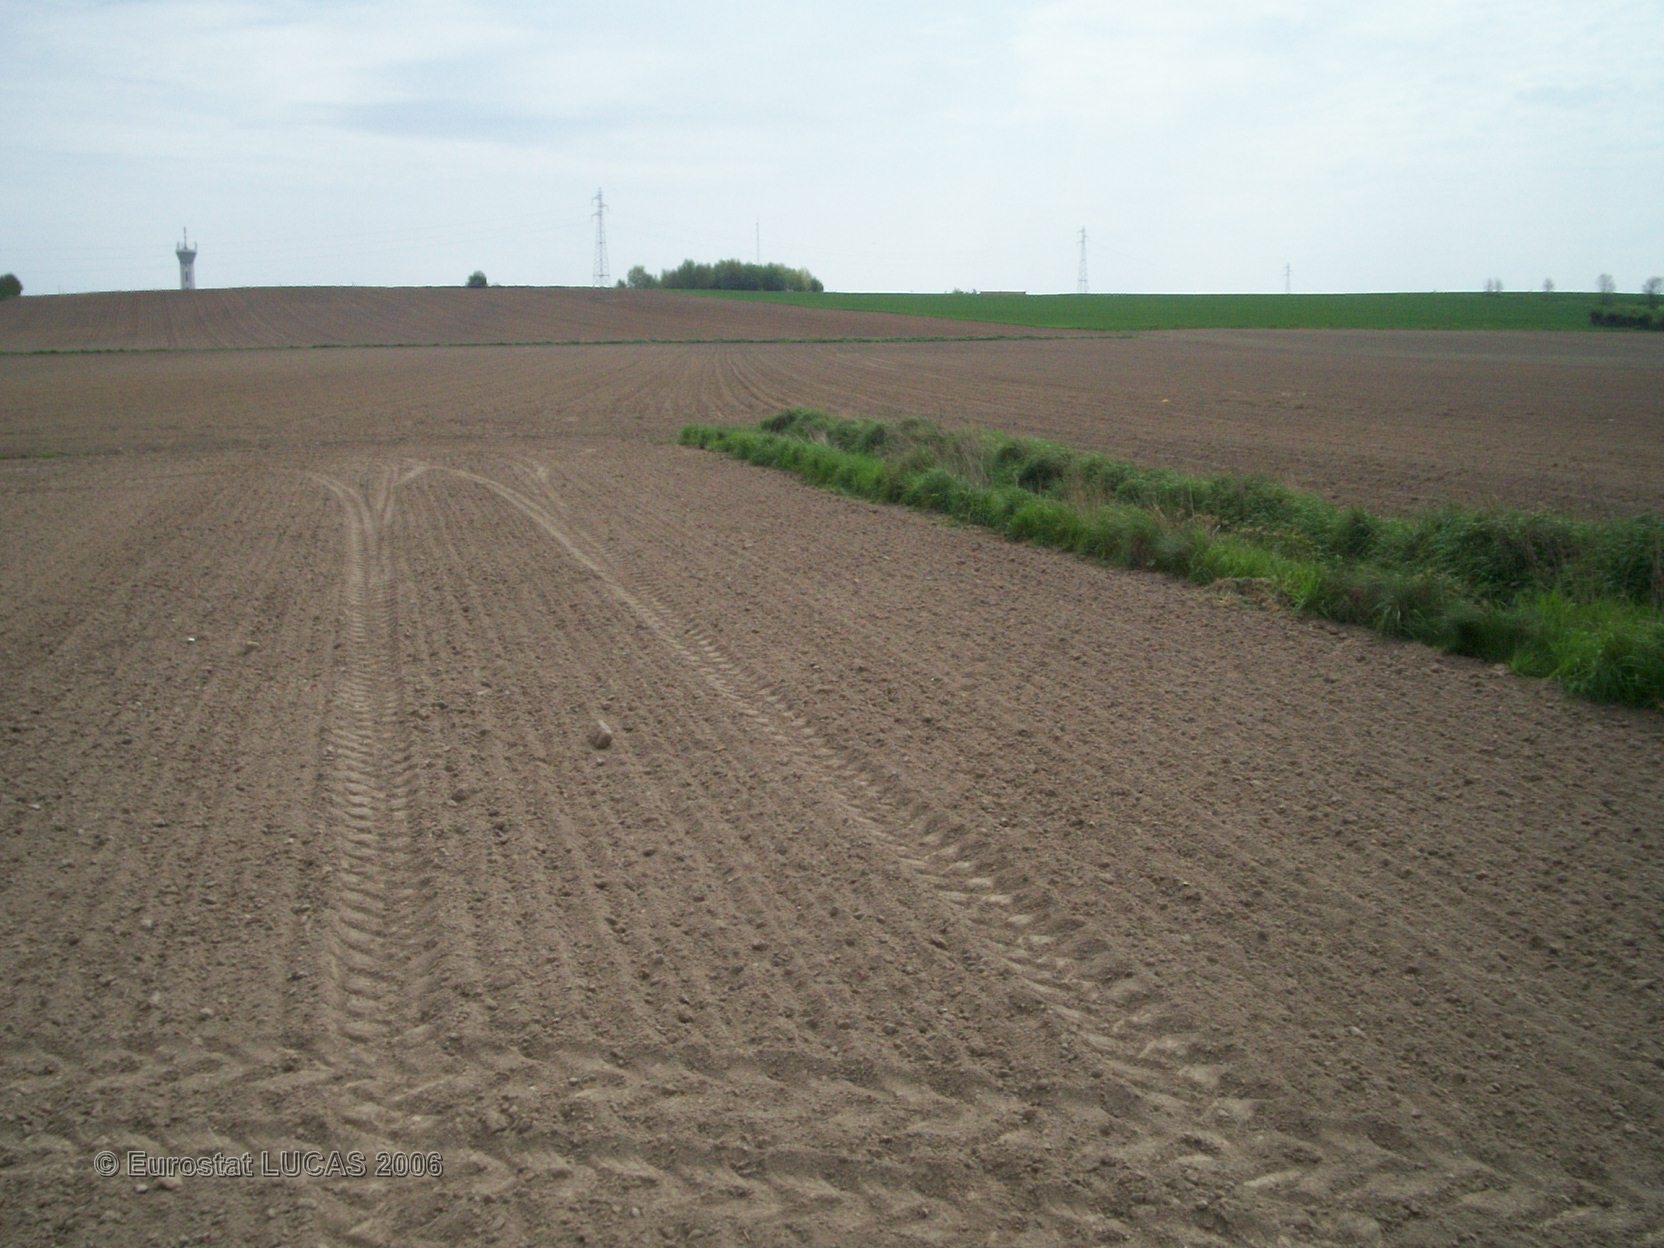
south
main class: Grassland
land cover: Grassland without tree/shrub cover
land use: Agriculture (excluding fallow land and kitchen gardens)
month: May
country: FR
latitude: 50.9382
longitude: 2.3444
